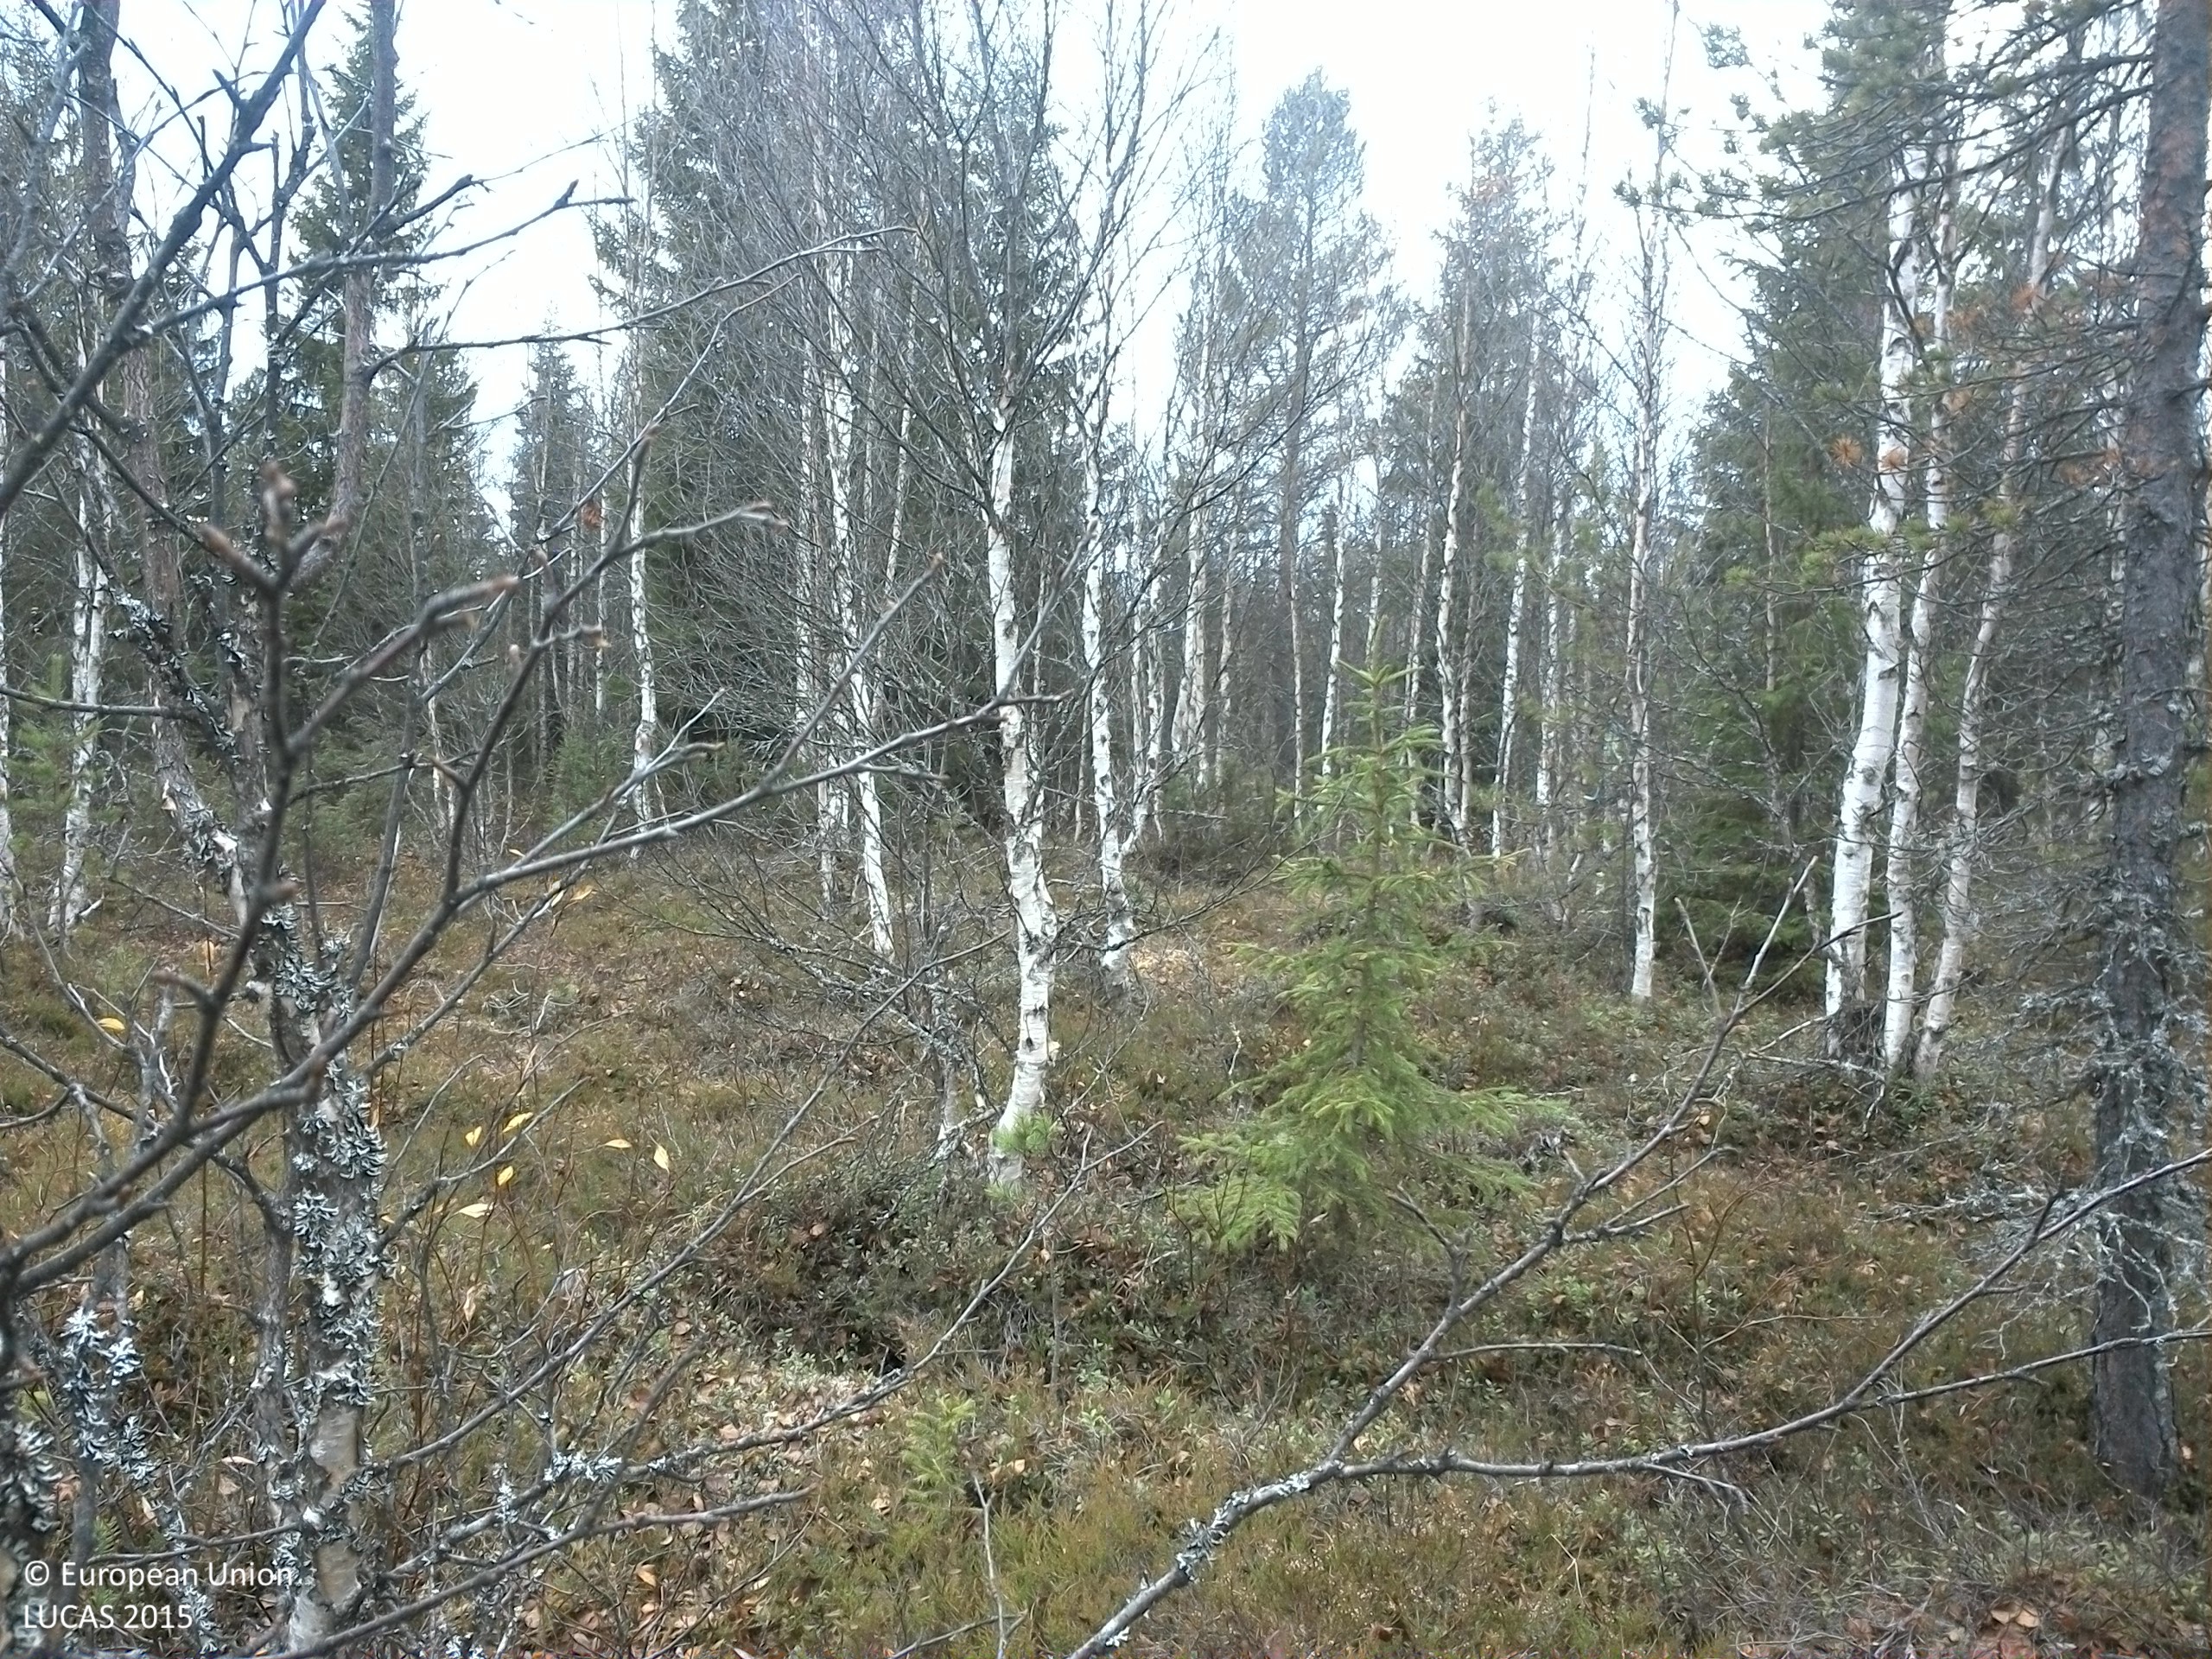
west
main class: Woodland
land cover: Spruce dominated mixed woodland
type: boreal forest
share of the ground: 25 - 50 %
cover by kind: shrubs 45 %, broadleaved forest trees 30 %, lichens and mosses 15 %, coniferous forest trees 10 %
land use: Forestry
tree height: > 5 m
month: October
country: SE
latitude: 64.2643
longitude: 15.5649
